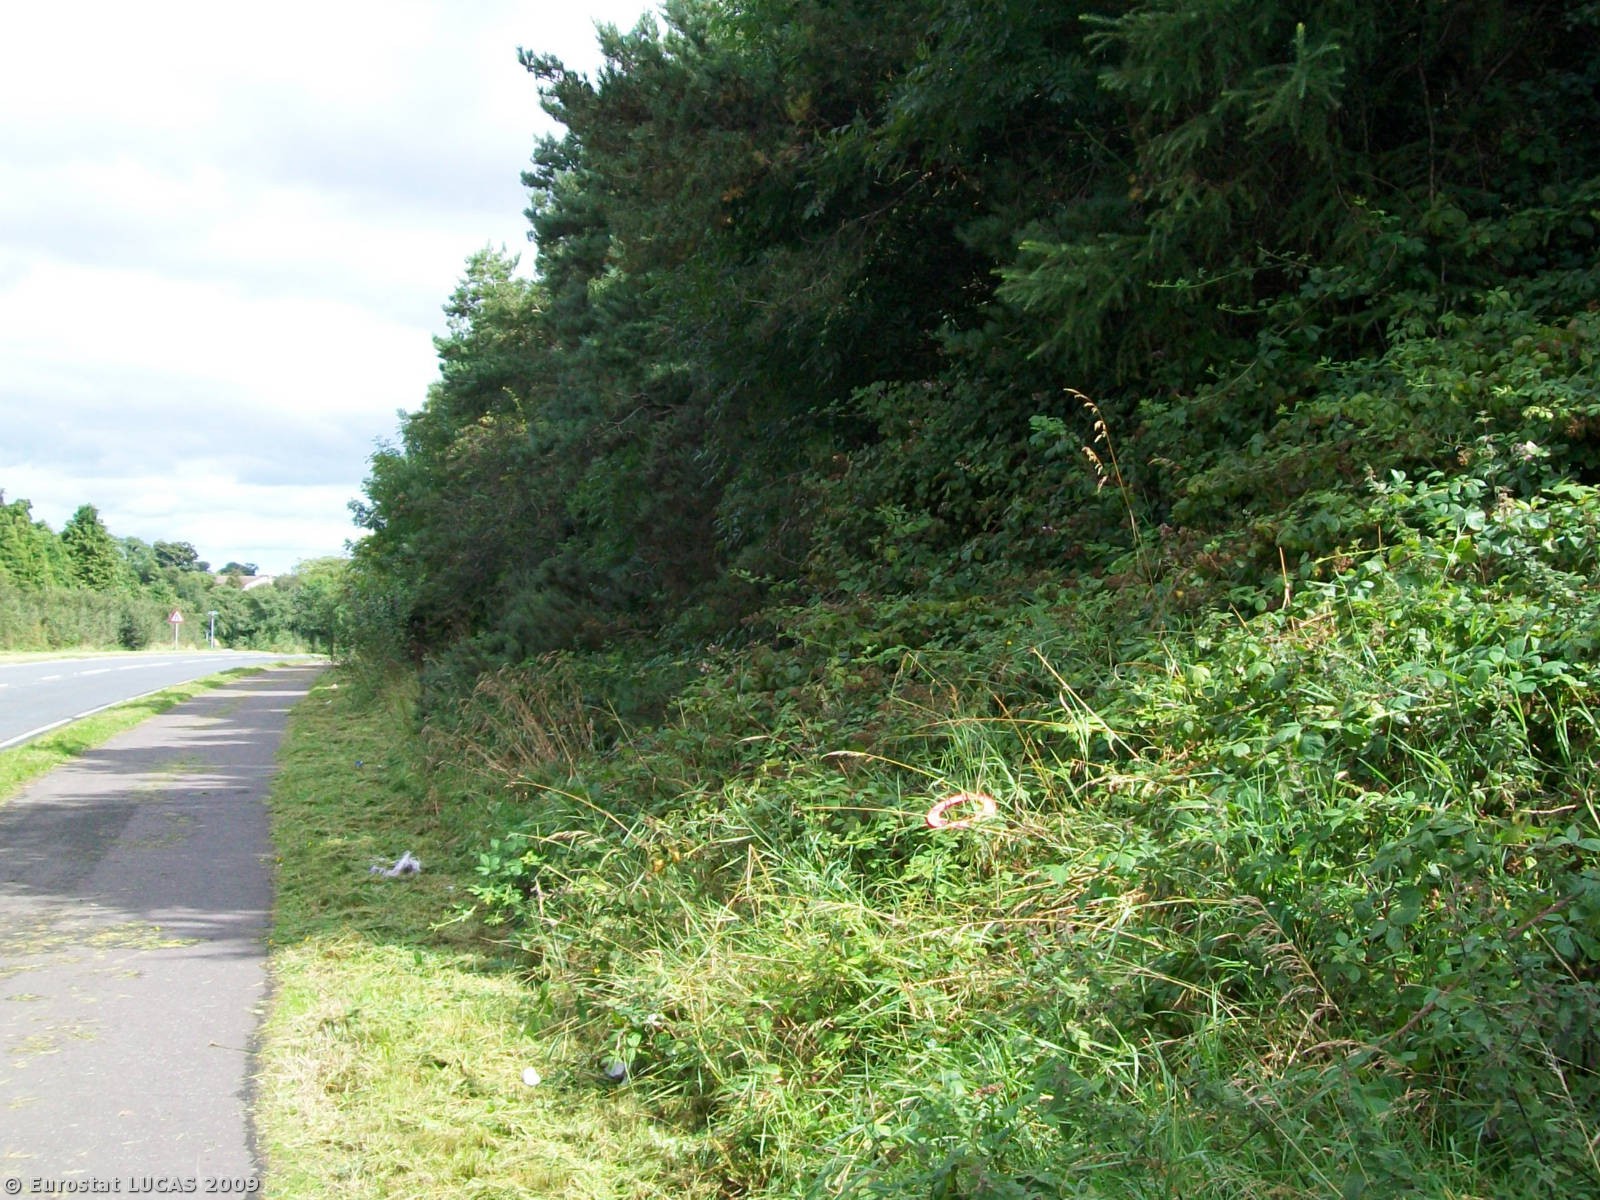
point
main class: Artificial land
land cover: Non built-up linear features
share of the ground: > 75 %
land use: Road transport
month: August
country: GB
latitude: 54.3901
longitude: -5.6708
